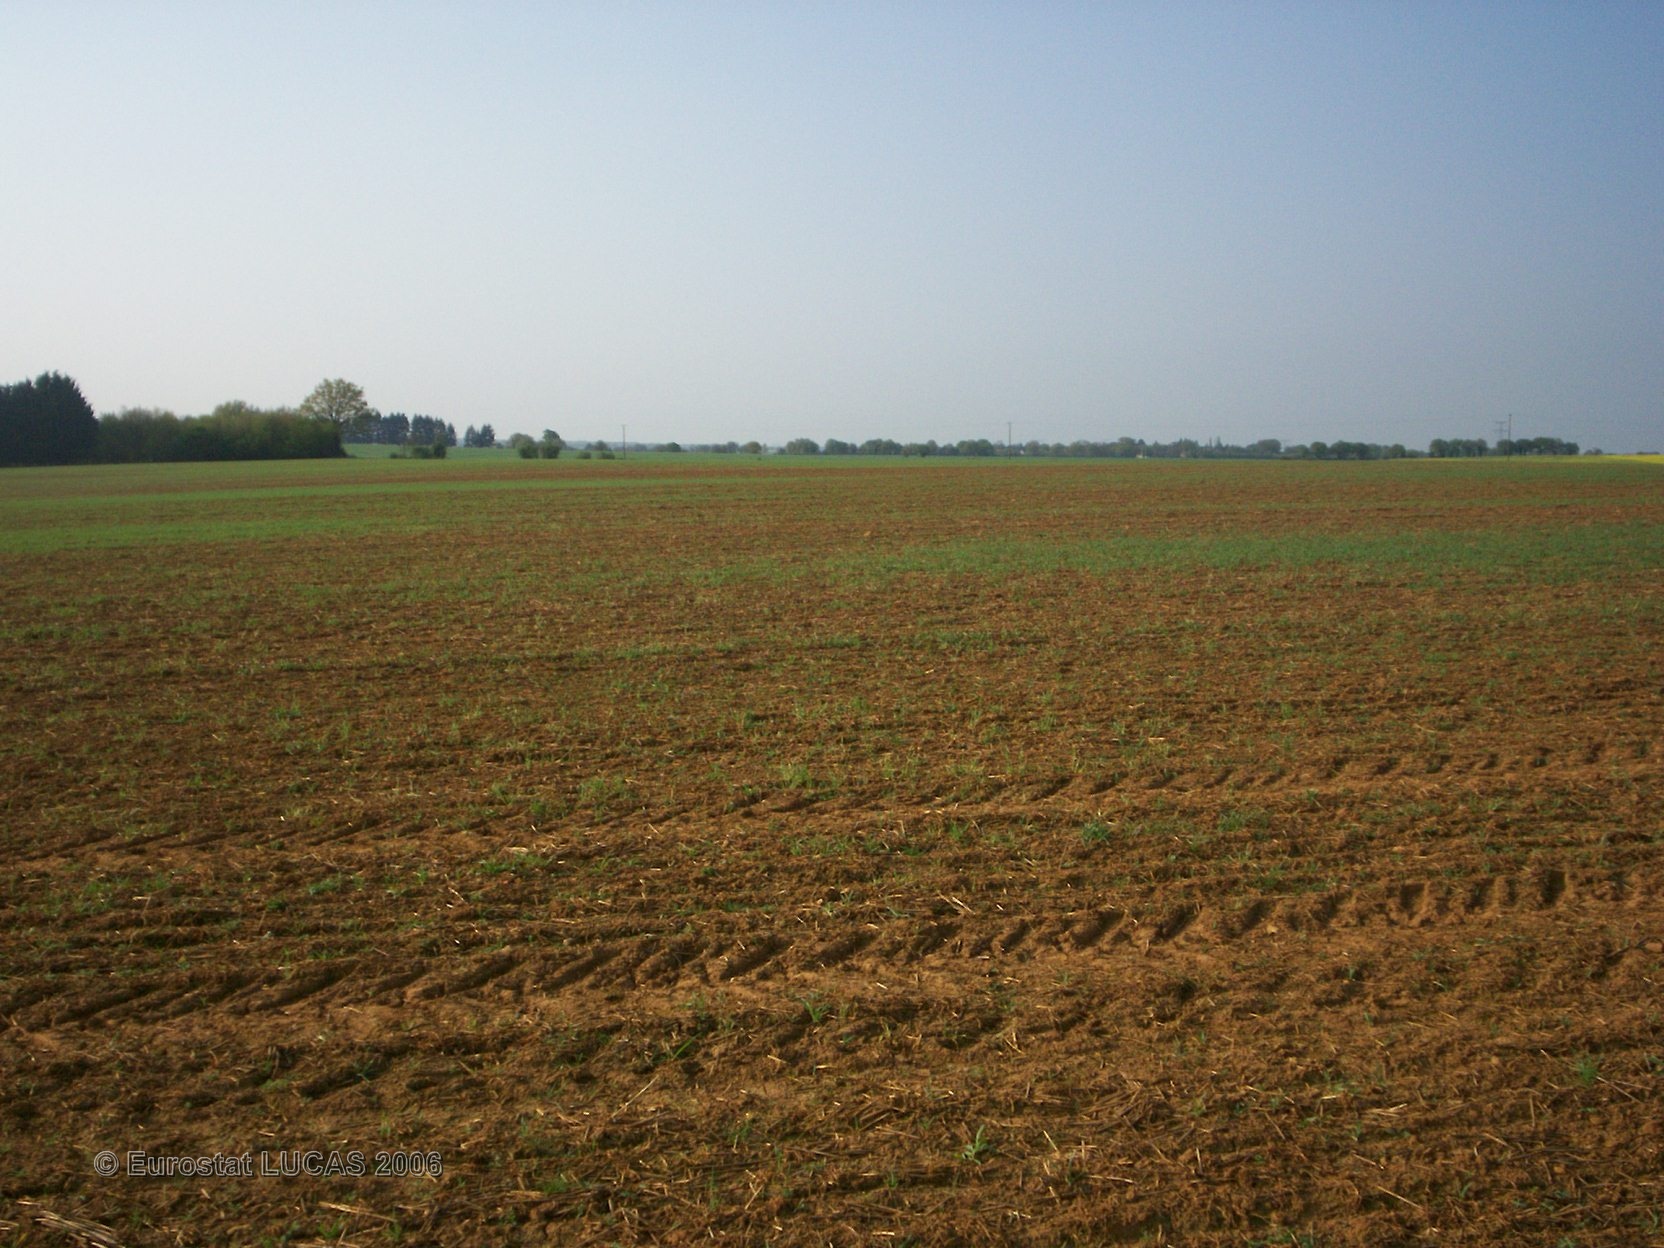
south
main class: Cropland
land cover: Barley
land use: Agriculture (excluding fallow land and kitchen gardens)
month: April
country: FR
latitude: 47.1923
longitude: 3.0662
